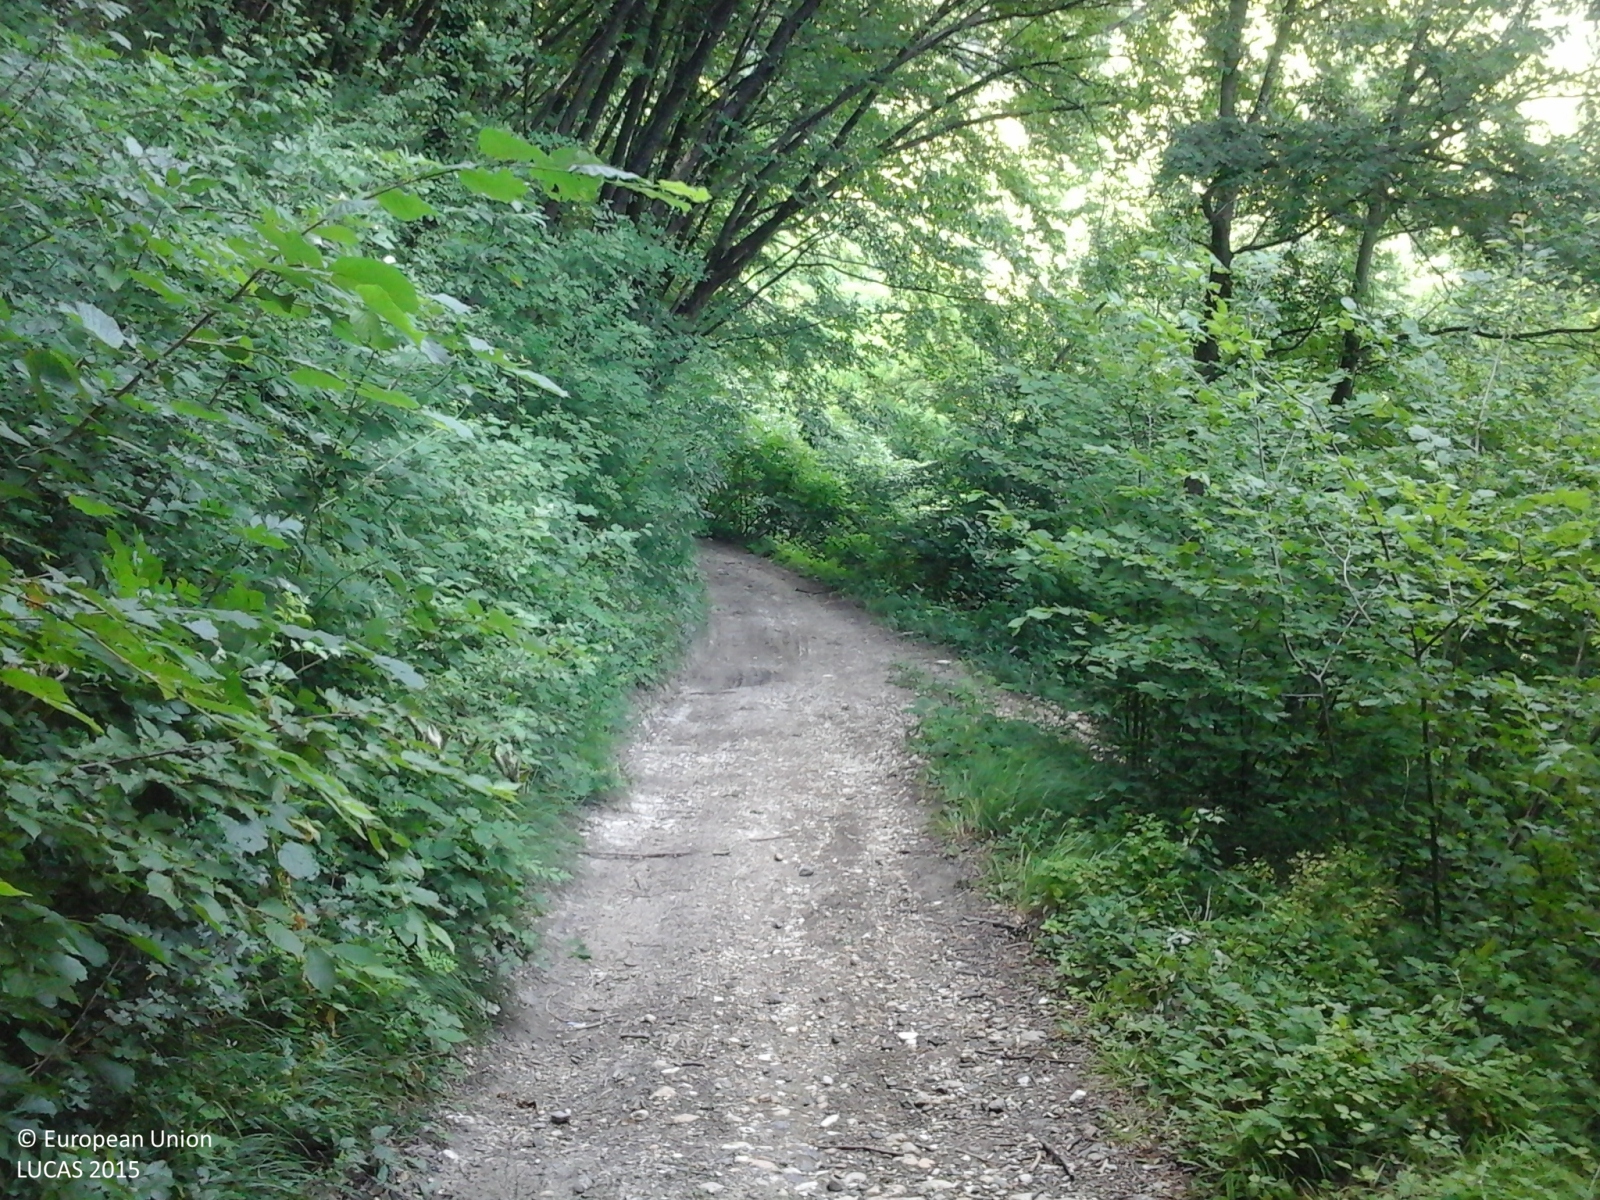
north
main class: Woodland
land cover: Broadleaved woodland
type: thermophilous deciduous forest
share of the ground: > 75 %
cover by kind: broadleaved forest trees 100 %
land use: Forestry
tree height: > 5 m
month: July
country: IT
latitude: 45.5518
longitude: 11.1893
